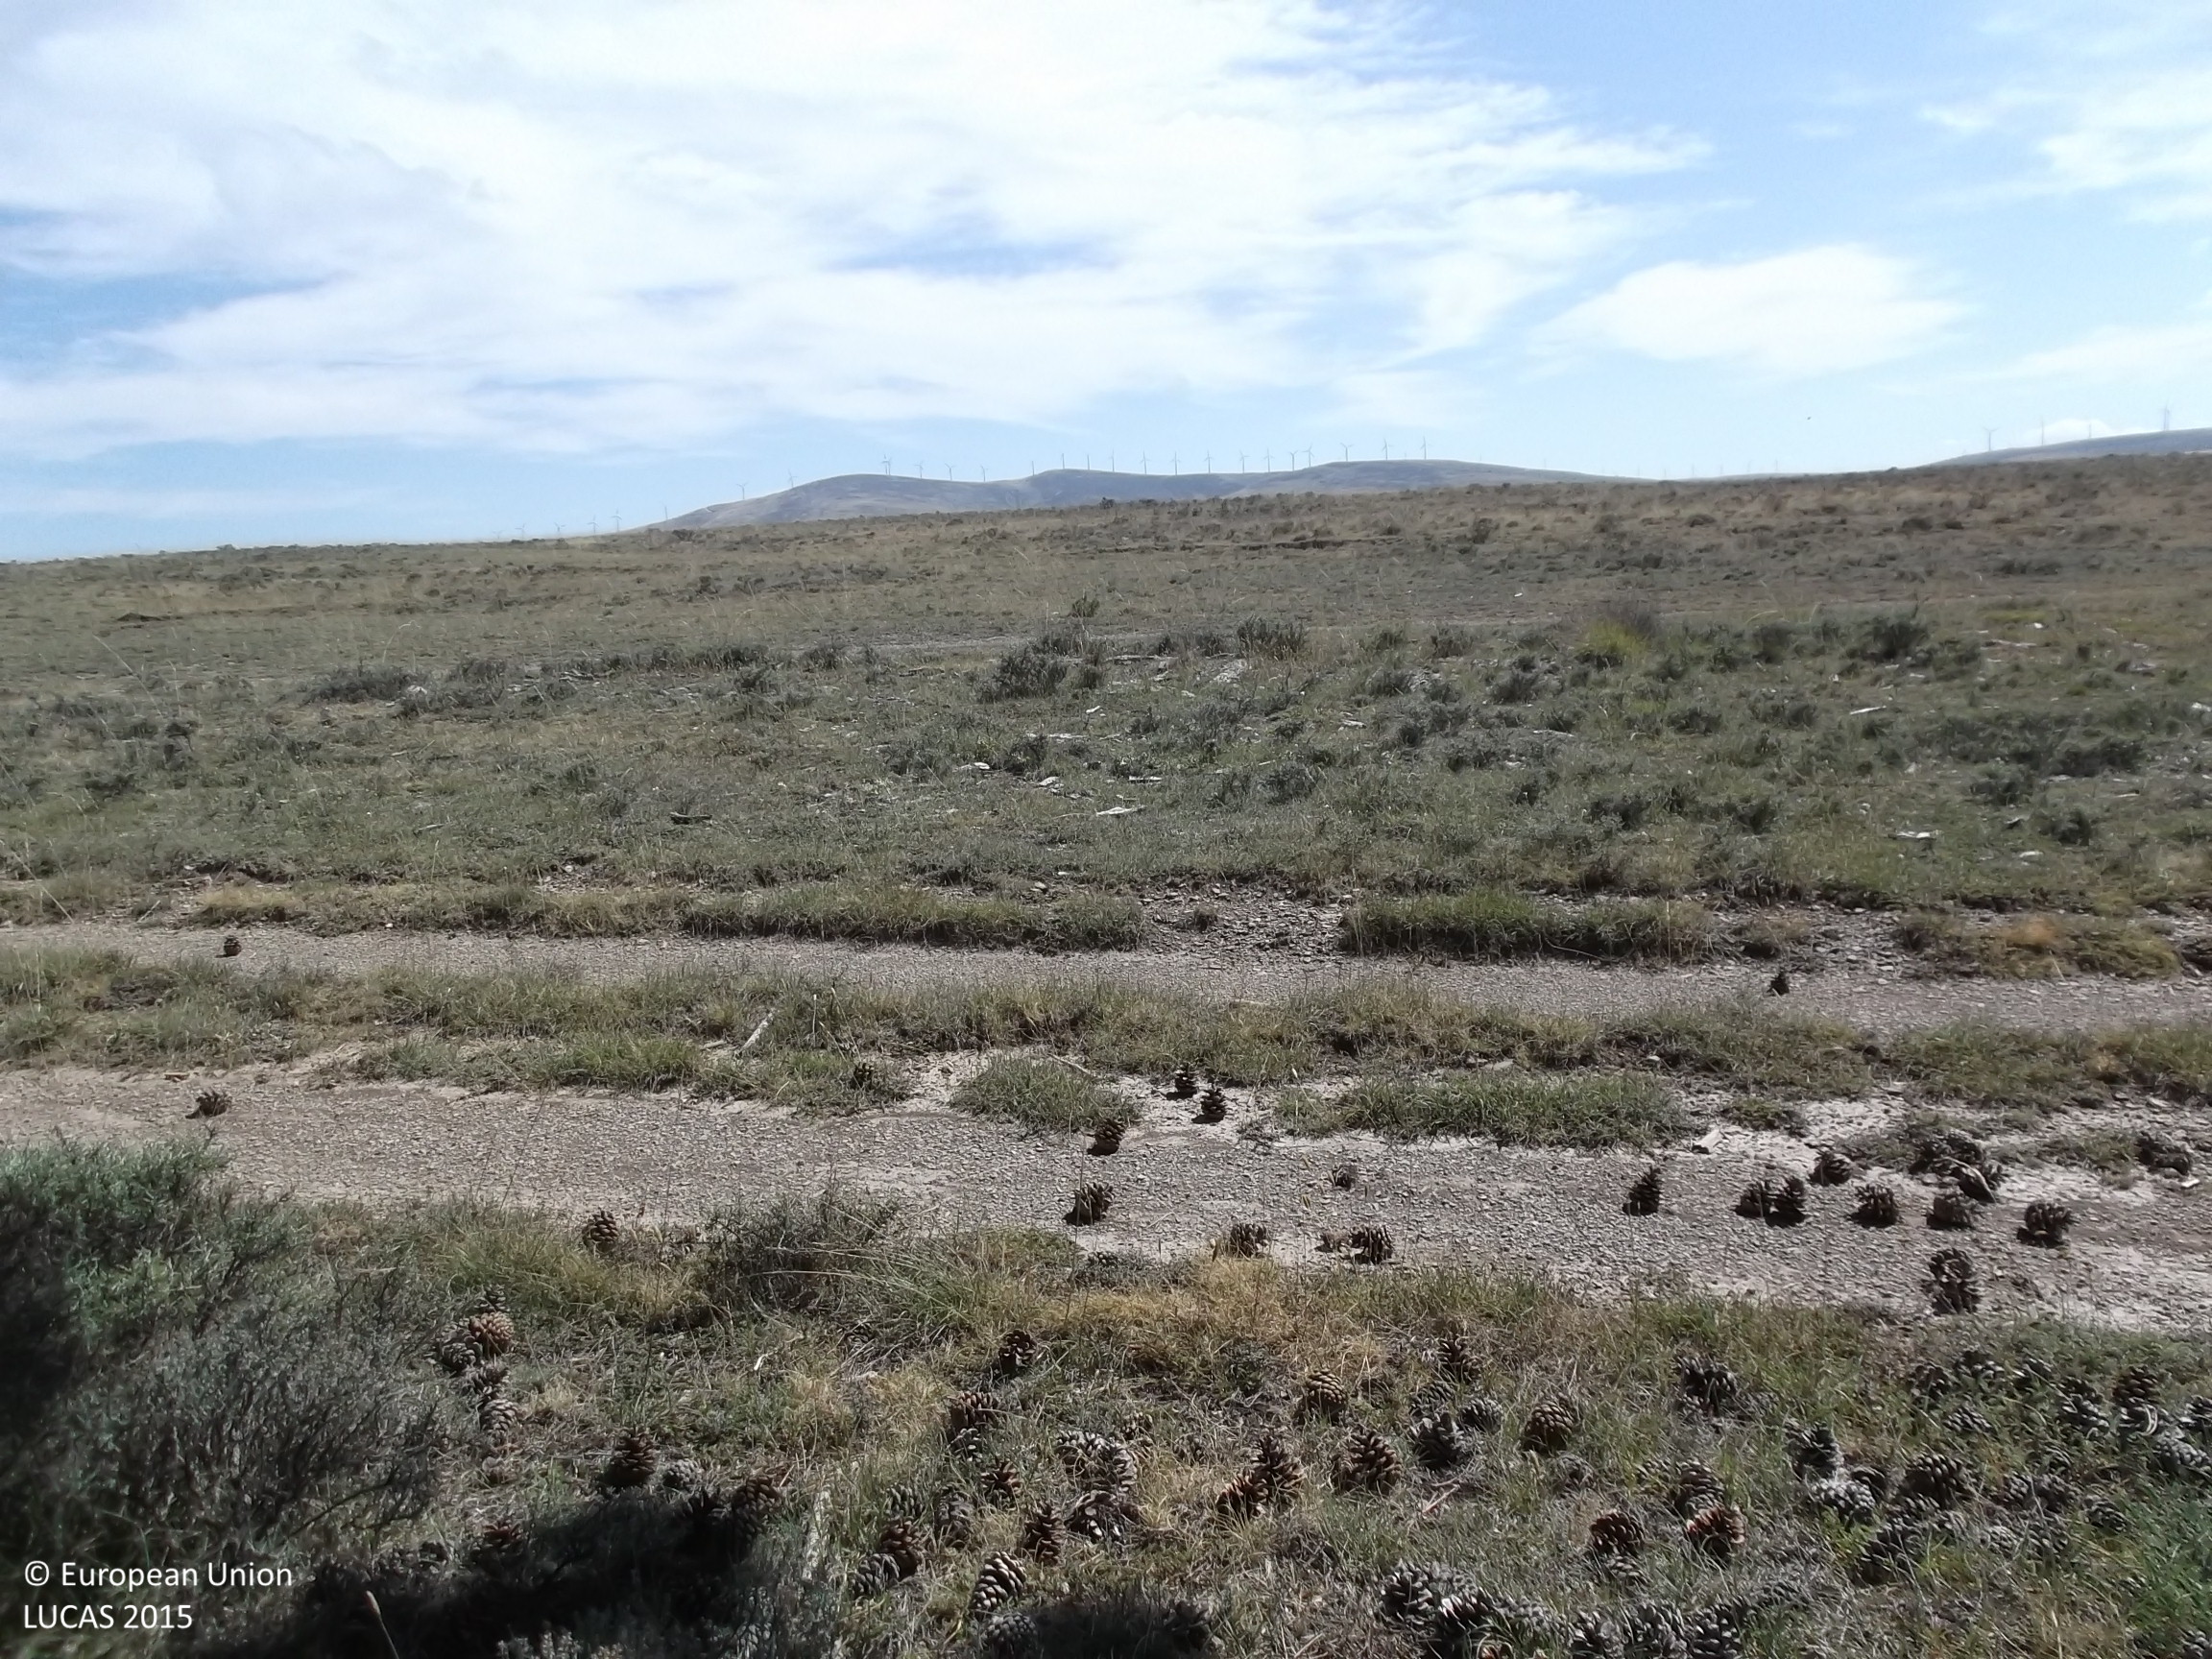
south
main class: Woodland
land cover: Pine dominated coniferous woodland
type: coniferous forest of the mediterranean region
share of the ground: > 75 %
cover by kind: coniferous forest trees 80 %, herbaceous plants 15 %, shrubs 5 %
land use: Forestry
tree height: > 5 m
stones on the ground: < 10 %
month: July
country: ES
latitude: 42.0441
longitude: -2.3257
